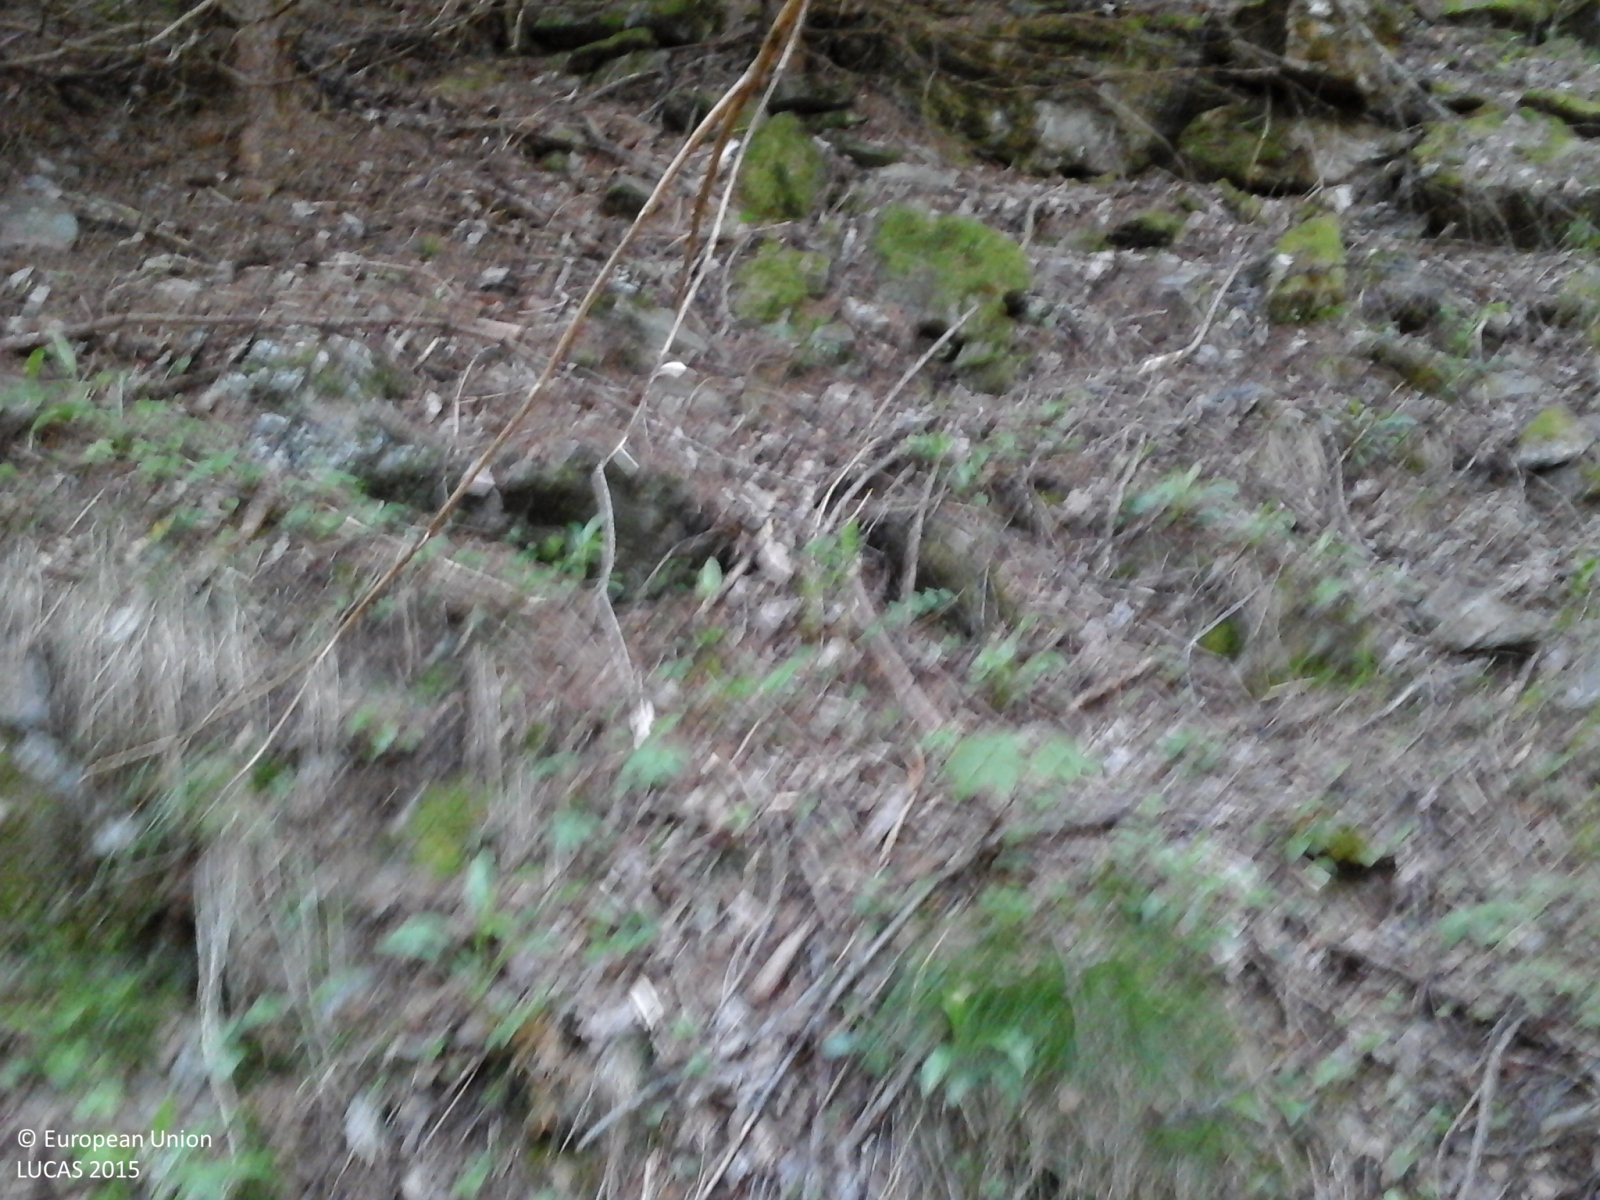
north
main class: Woodland
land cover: Spruce dominated coniferous woodland
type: alpine coniferous forest
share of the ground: > 75 %
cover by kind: coniferous forest trees 100 %
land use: Forestry
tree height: > 5 m
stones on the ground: > 50 %
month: May
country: IT
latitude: 46.4918
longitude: 10.8718
